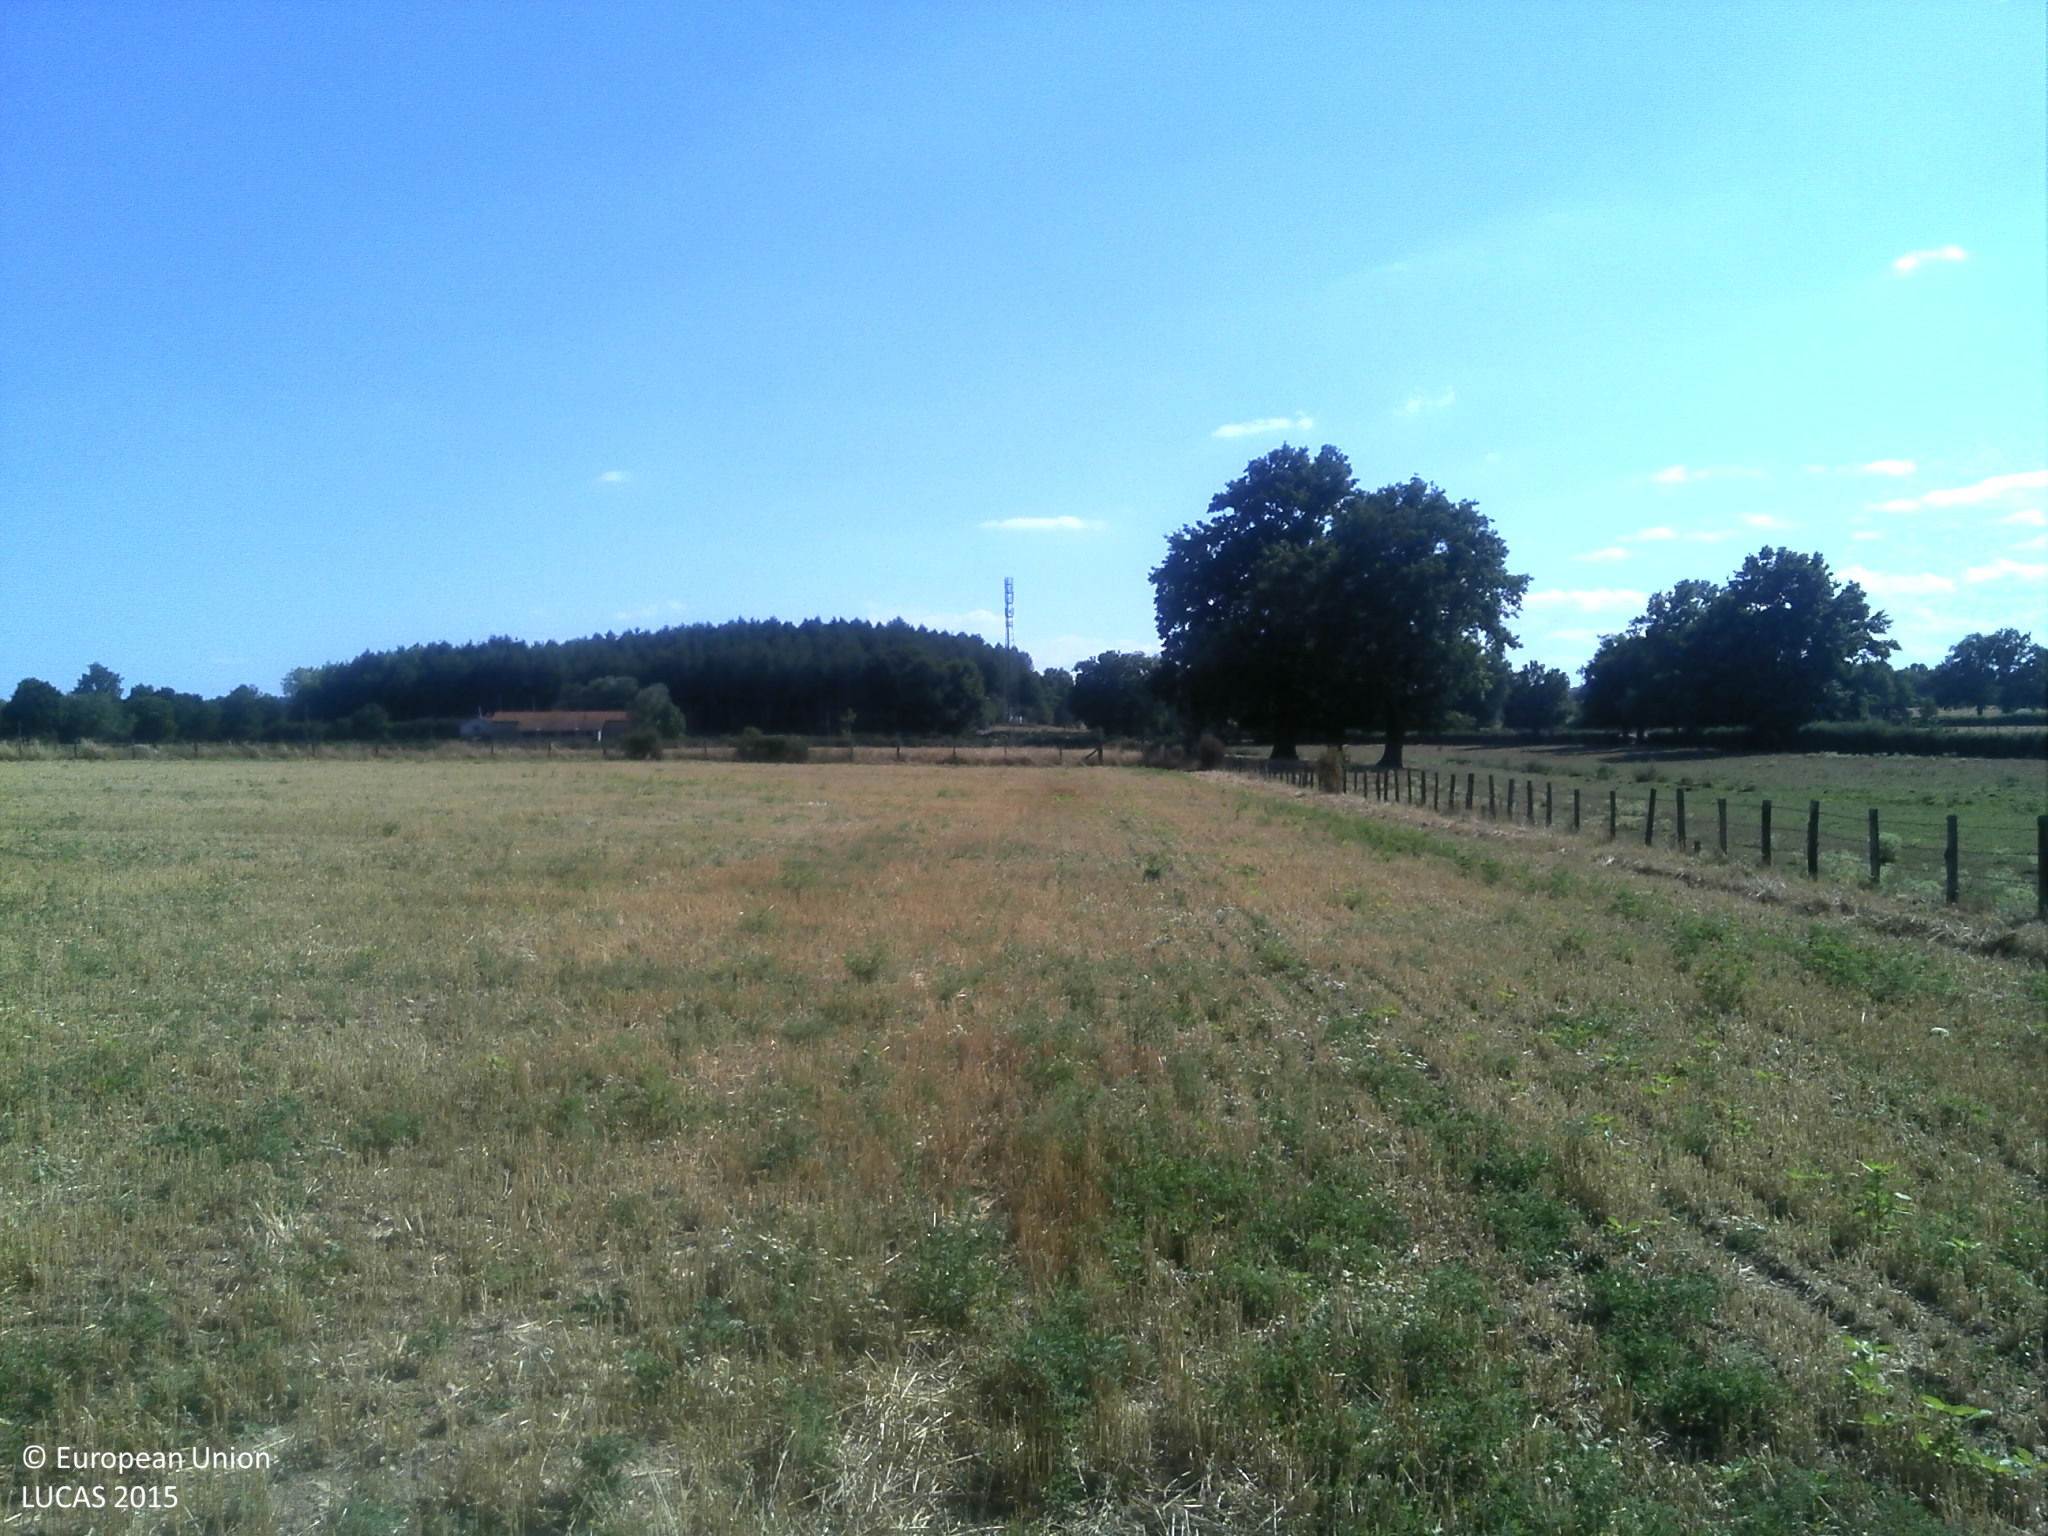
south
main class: Cropland
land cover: Barley
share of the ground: 50 - 75 %
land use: Agriculture (excluding fallow land and kitchen gardens)
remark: Harvested field
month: July
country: FR
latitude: 46.0063
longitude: 4.0742
